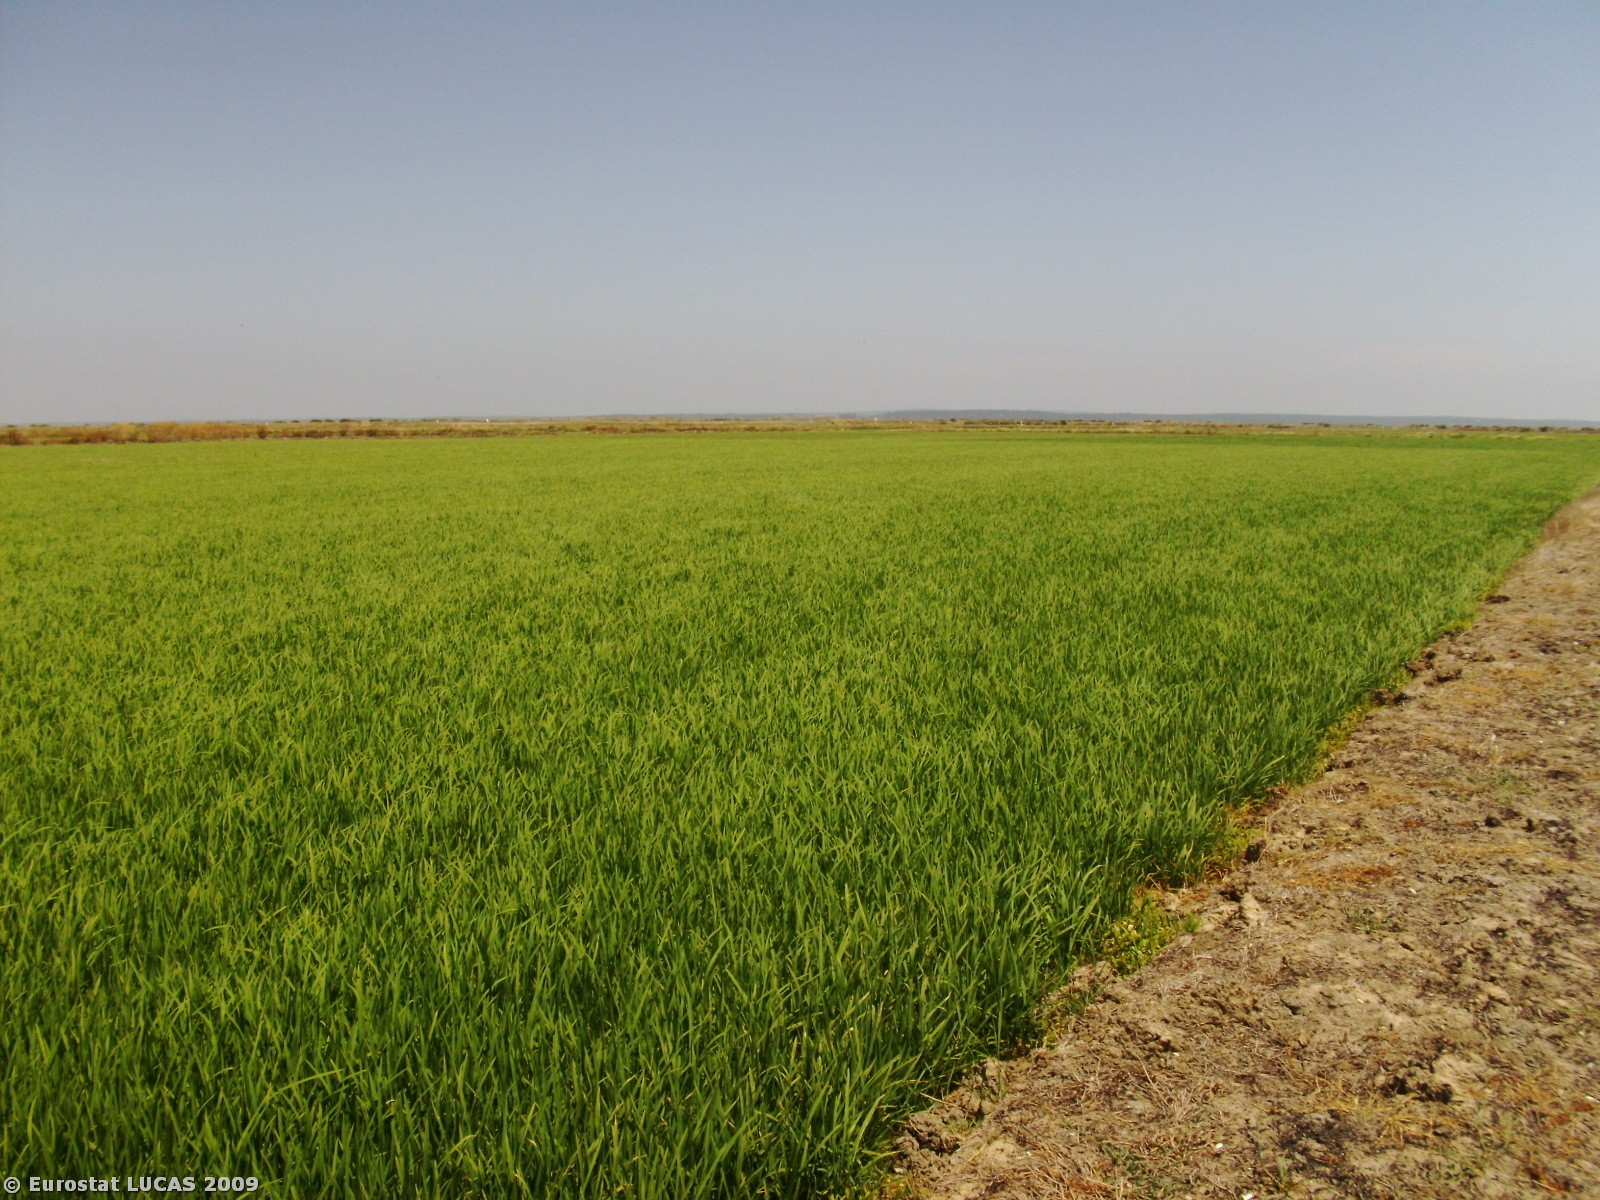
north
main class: Cropland
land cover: Rice
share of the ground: > 75 %
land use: Agriculture (excluding fallow land and kitchen gardens)
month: June
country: PT
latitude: 38.4158
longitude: -8.7847
